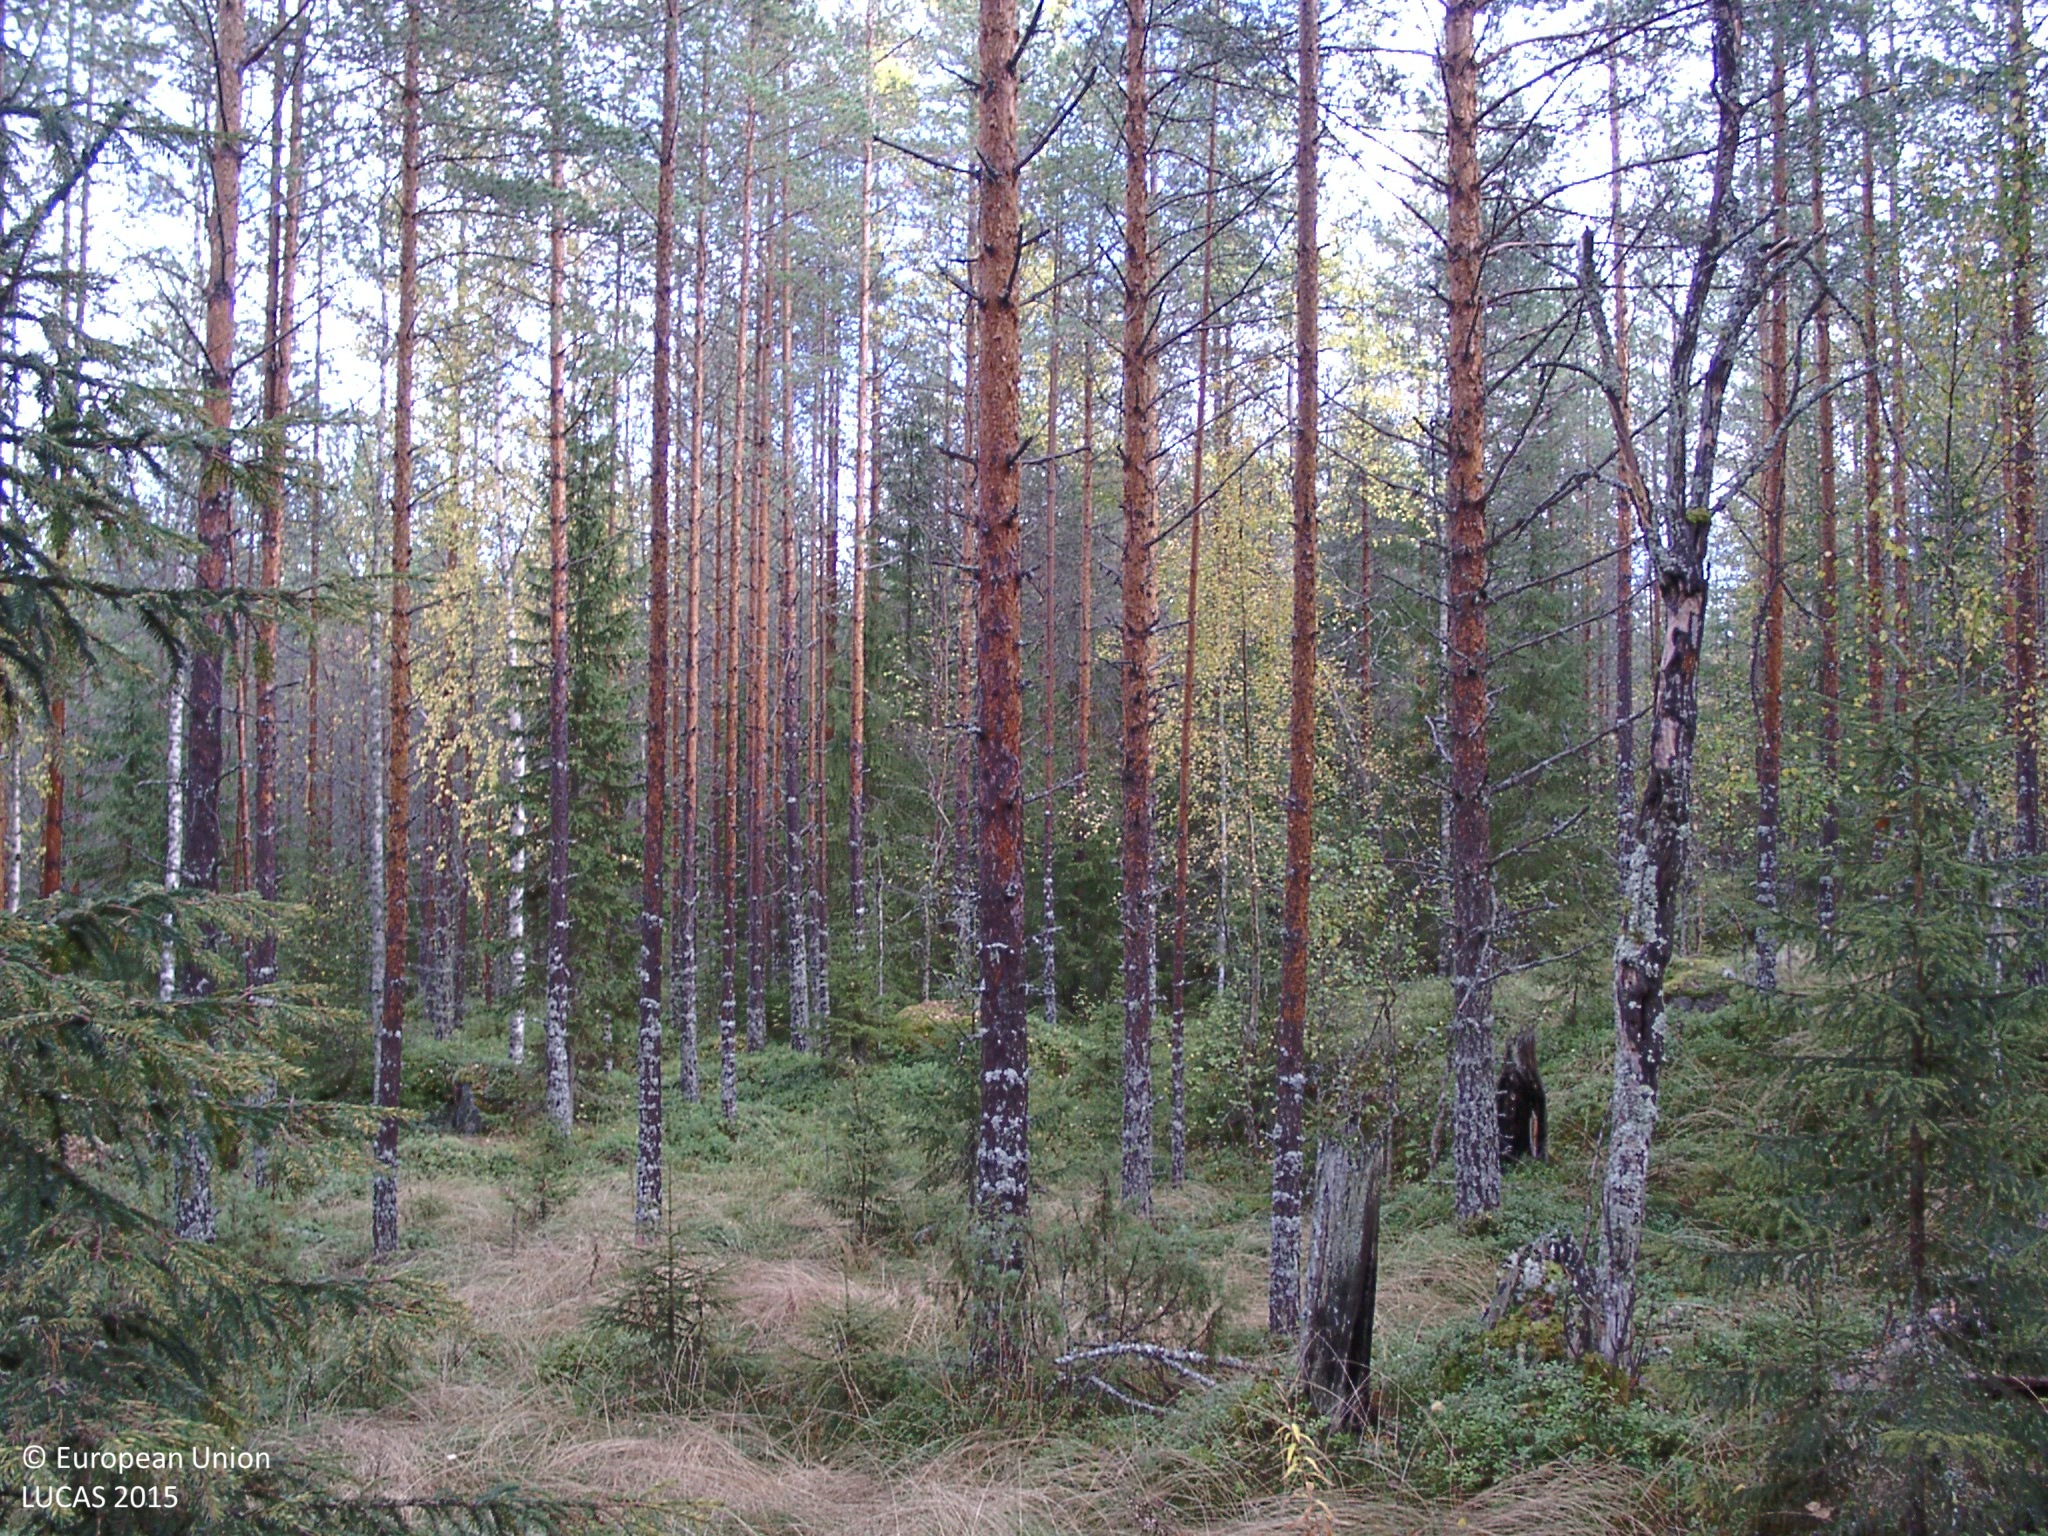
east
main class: Woodland
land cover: Pine dominated coniferous woodland
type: boreal forest
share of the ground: 50 - 75 %
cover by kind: coniferous forest trees 60 %, shrubs 15 %, herbaceous plants 15 %, lichens and mosses 10 %
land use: Forestry
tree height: > 5 m
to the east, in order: Pine dominated coniferous woodland; Other coniferous woodland; Pine dominated coniferous woodland; Other coniferous woodland
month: September
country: FI
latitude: 62.7436
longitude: 25.6735
